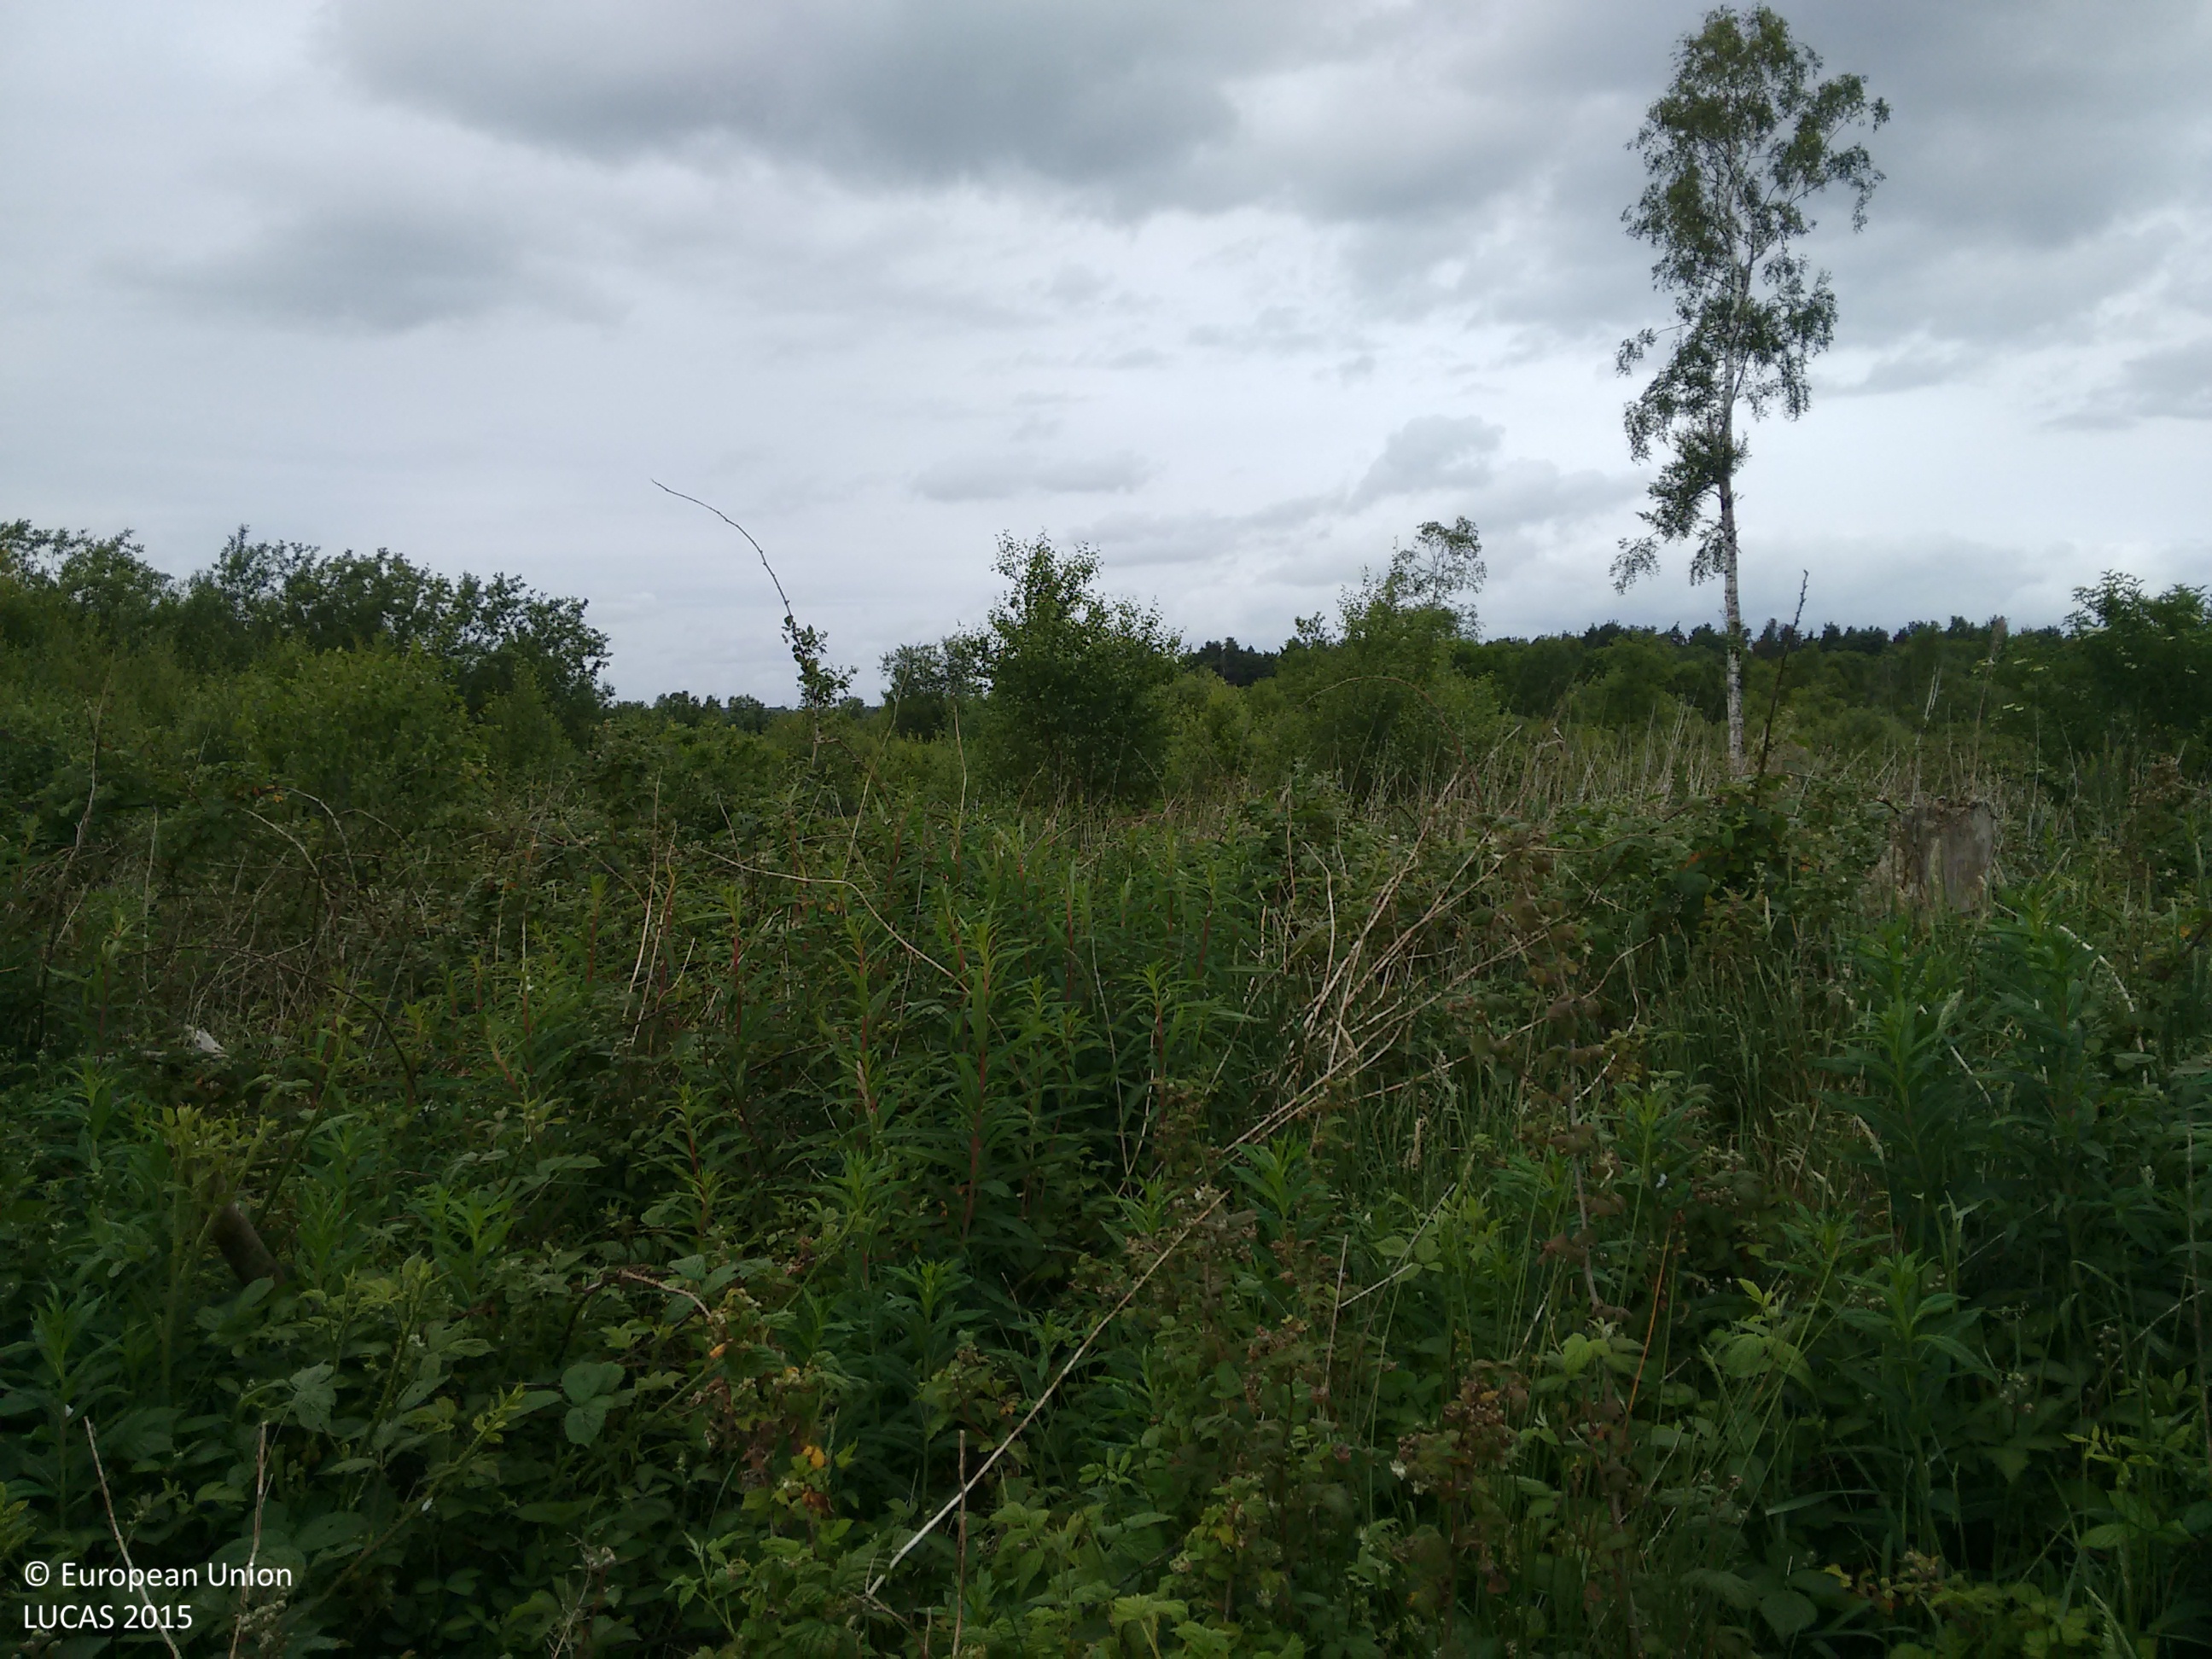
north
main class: Shrubland
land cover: Shrubland without tree cover
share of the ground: > 75 %
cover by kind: herbaceous plants 80 %, shrubs 20 %
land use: Forestry
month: June
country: IE
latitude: 53.7468
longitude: -6.7689
